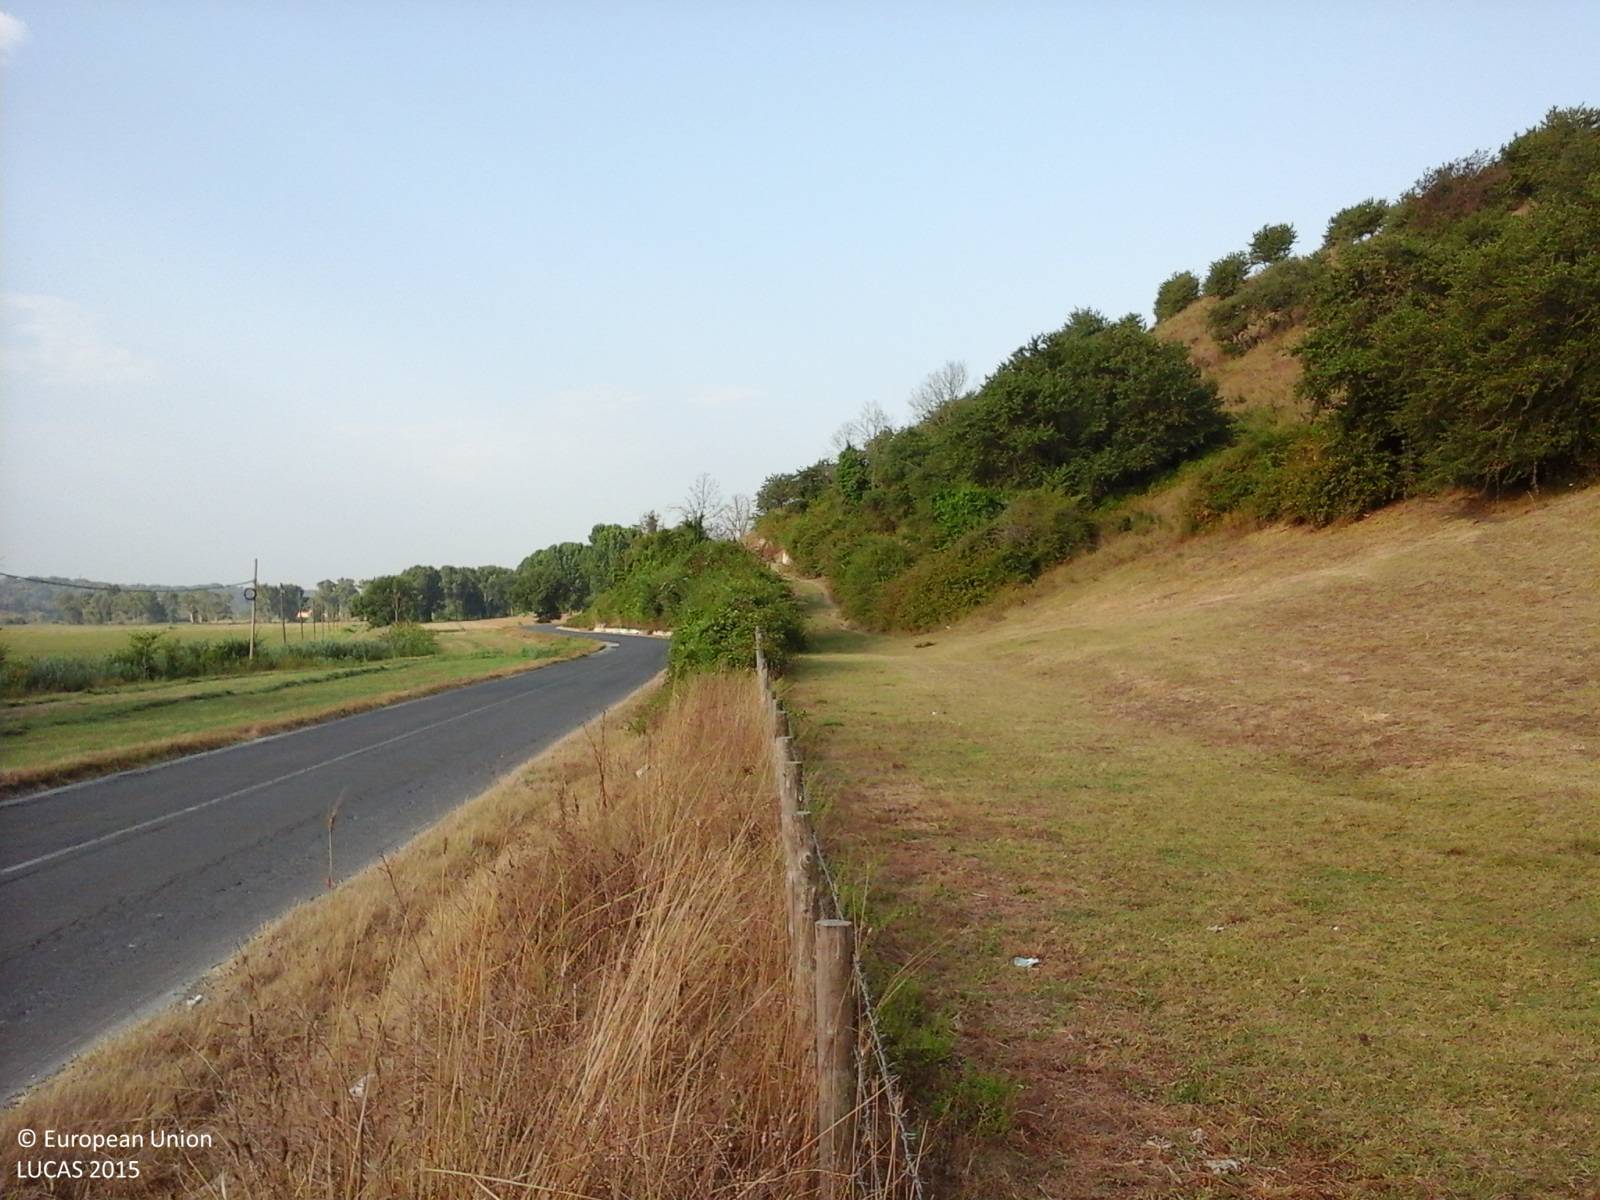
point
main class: Grassland
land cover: Grassland without tree/shrub cover
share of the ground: > 75 %
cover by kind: herbaceous plants 100 %
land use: Agriculture (excluding fallow land and kitchen gardens)
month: July
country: IT
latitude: 41.9237
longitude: 12.2705
